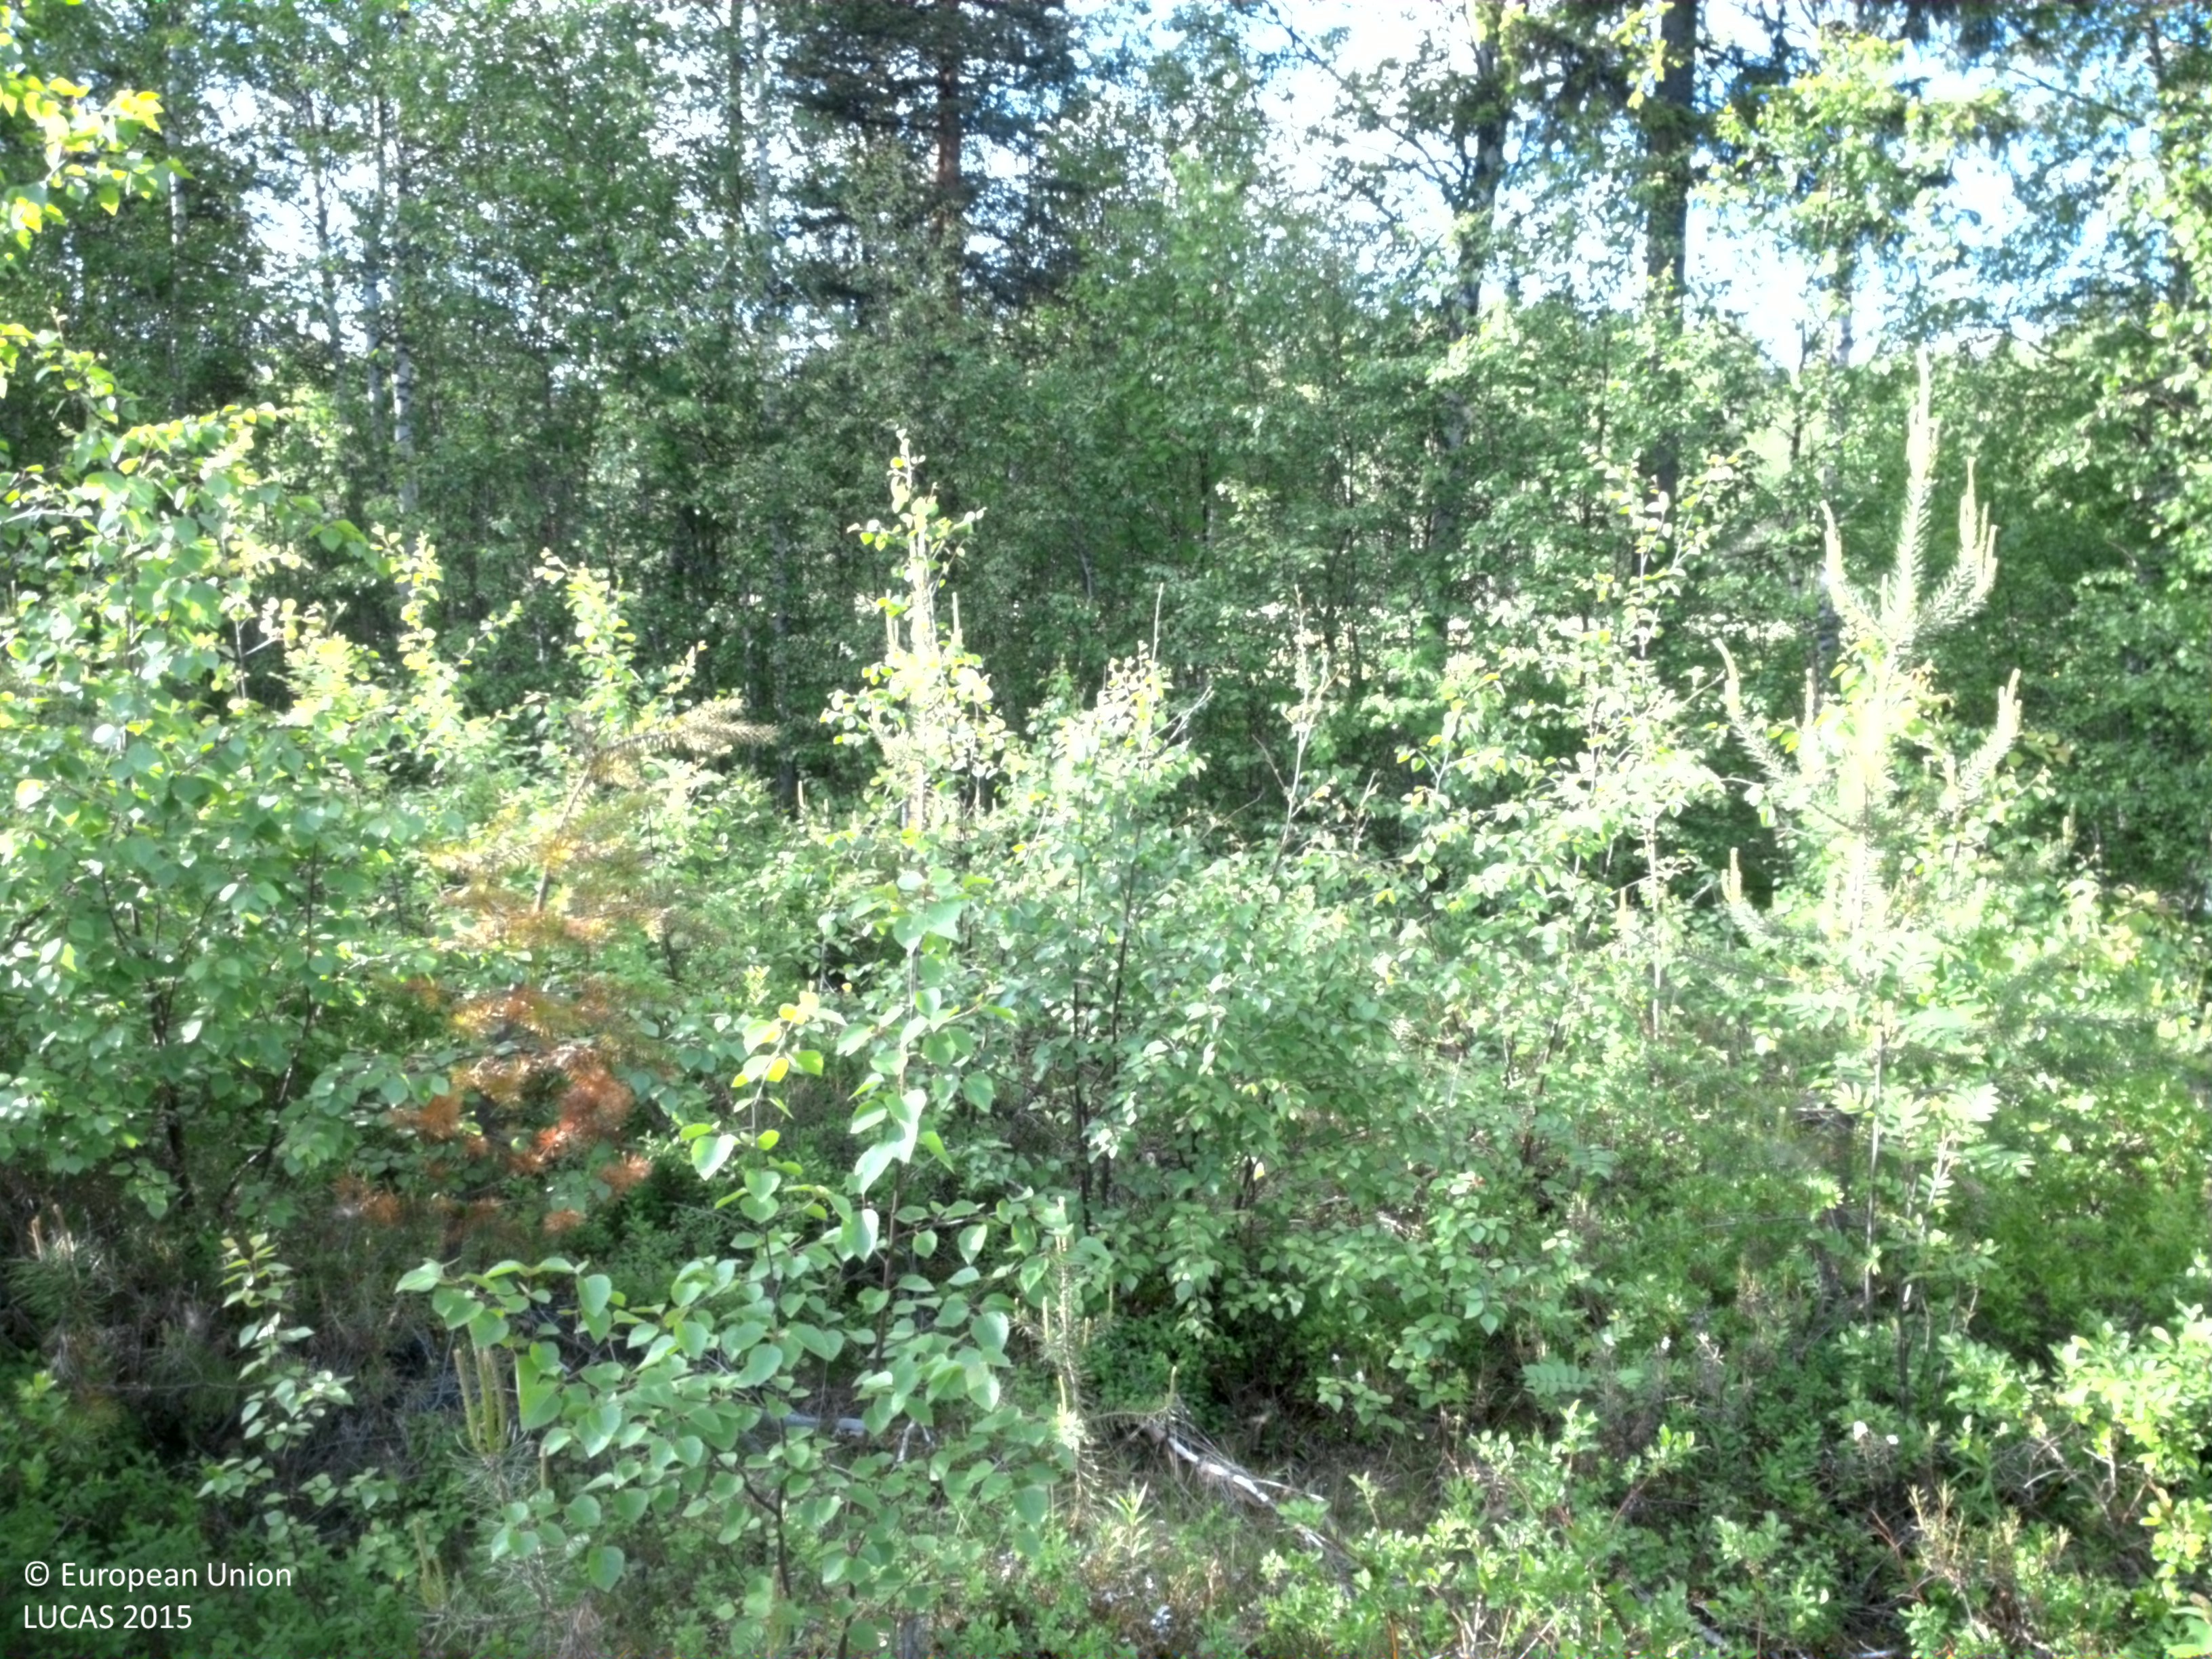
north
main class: Woodland
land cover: Pine dominated mixed woodland
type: boreal forest
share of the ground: 50 - 75 %
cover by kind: broadleaved forest trees 45 %, shrubs 30 %, coniferous forest trees 20 %, lichens and mosses 5 %
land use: Forestry
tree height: < 5 m
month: June
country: SE
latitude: 66.3827
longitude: 22.7034
